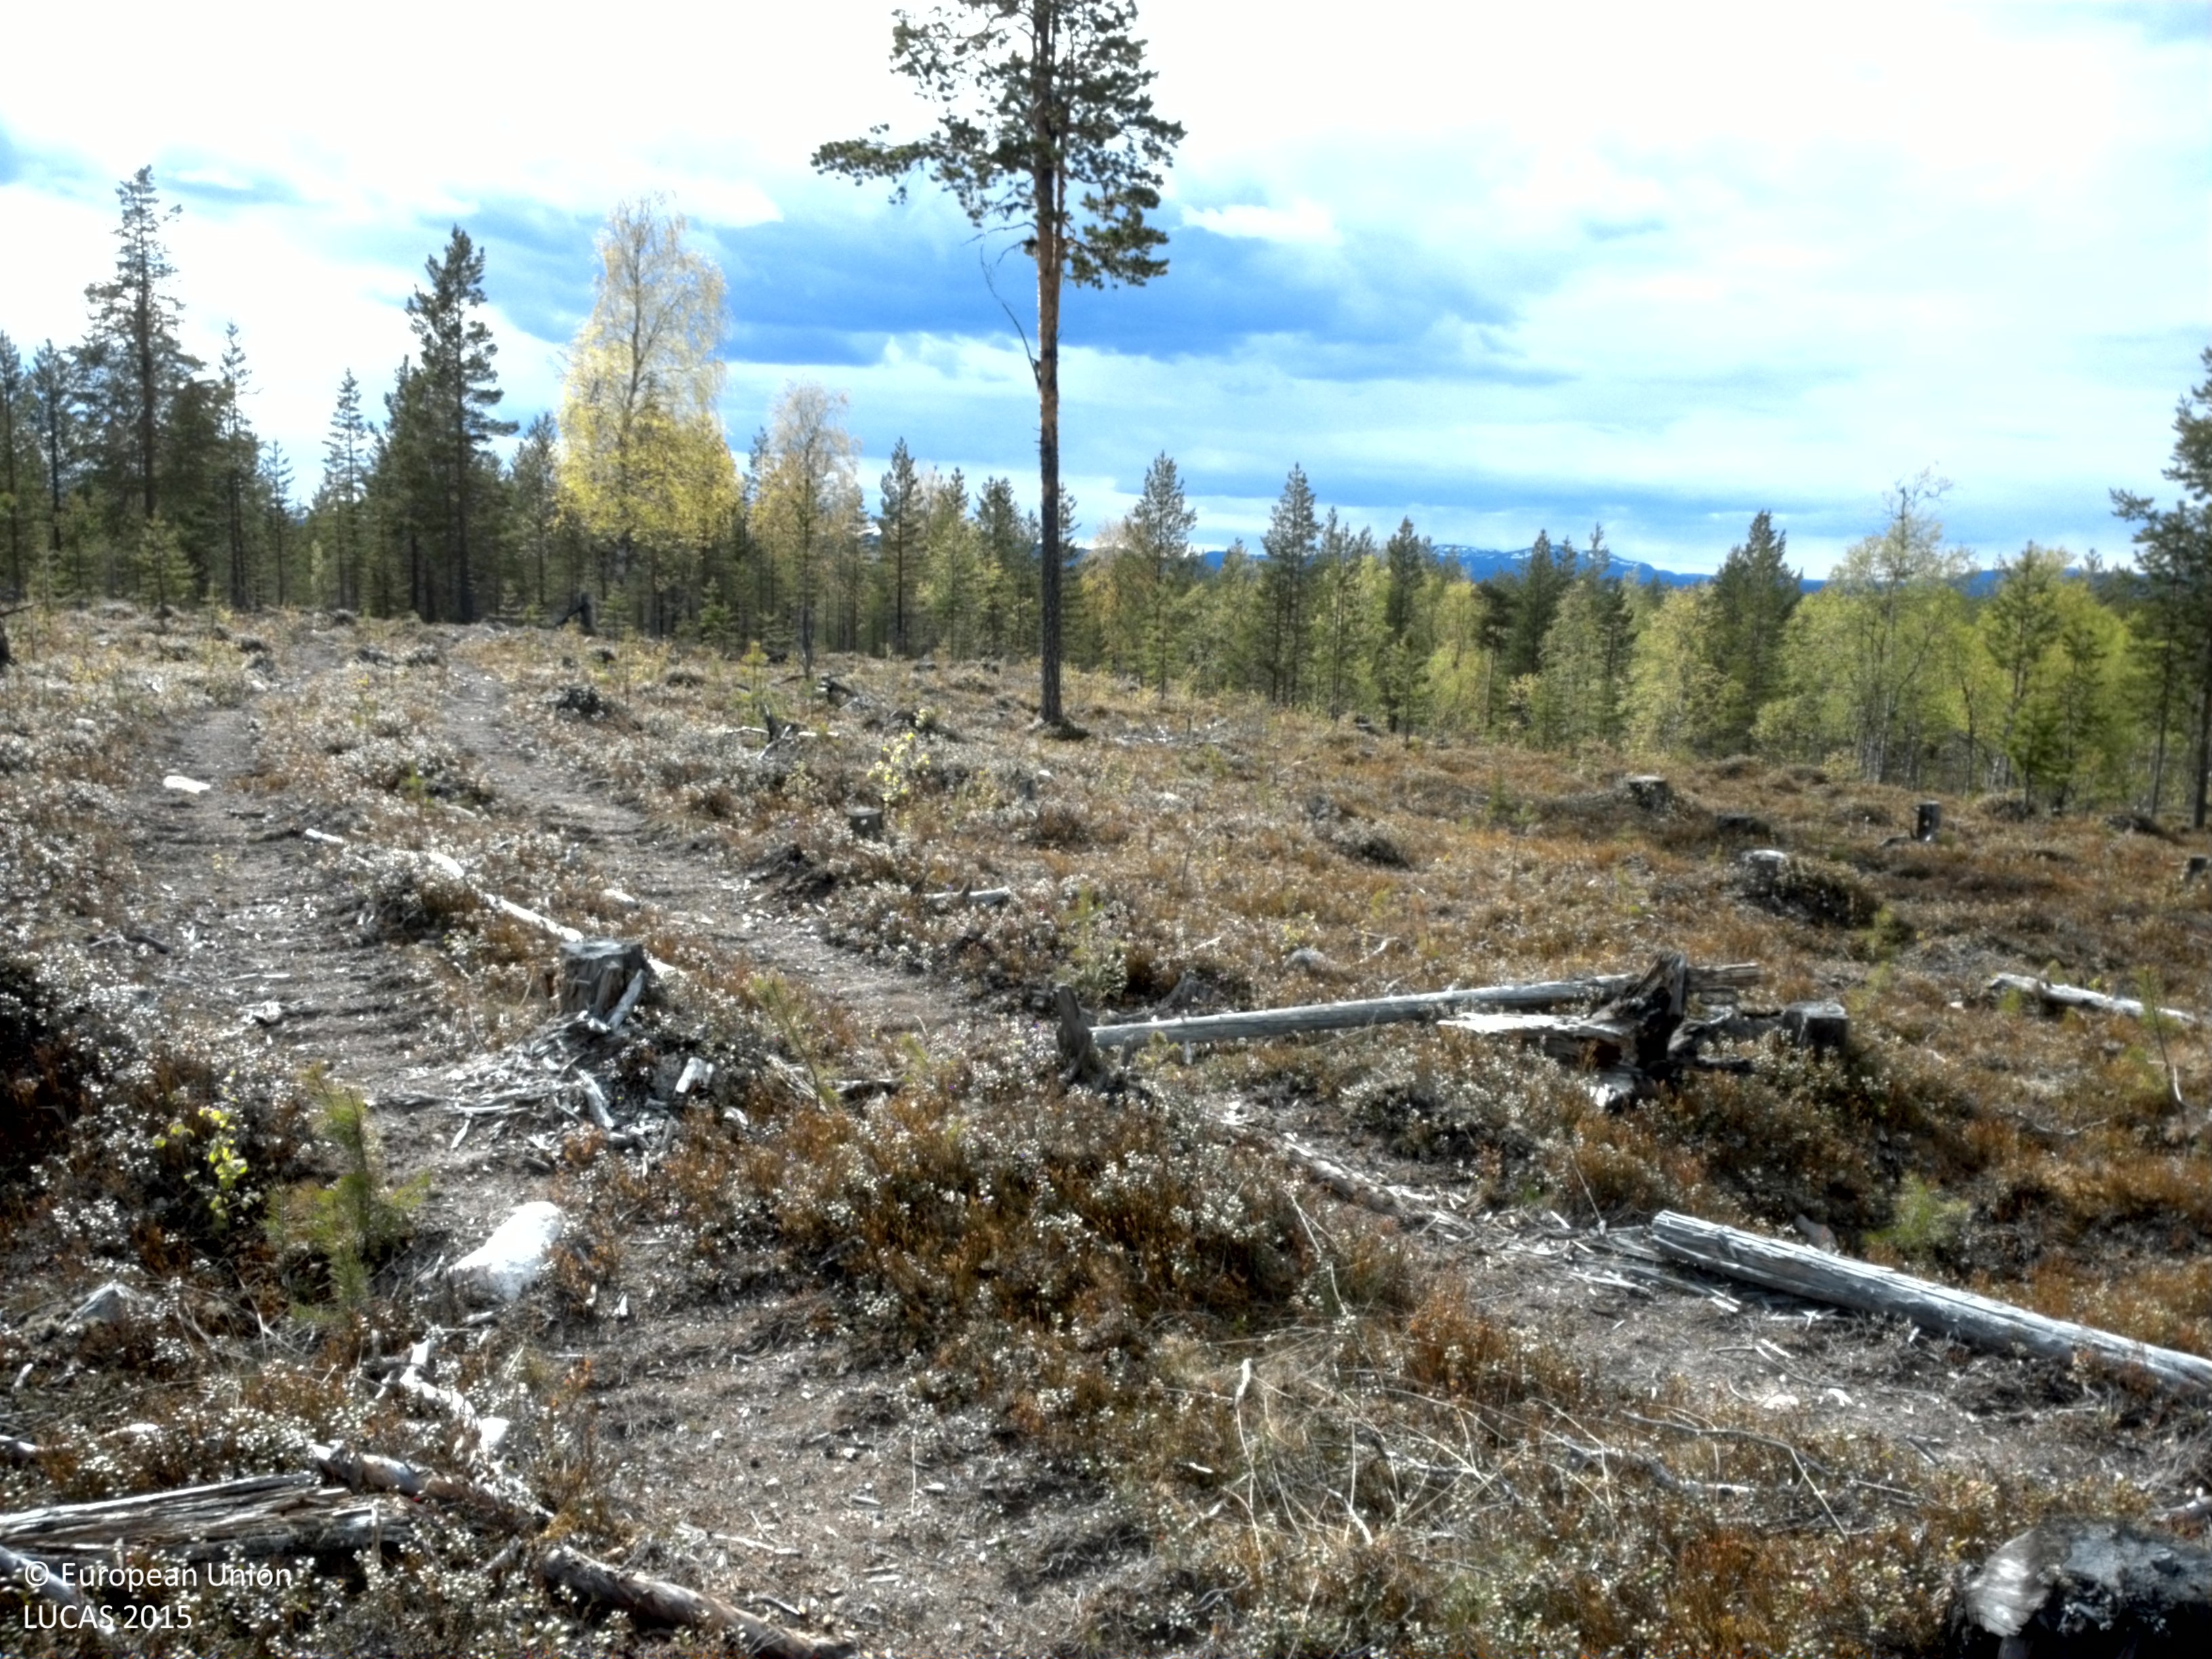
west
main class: Shrubland
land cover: Shrubland with sparse tree cover
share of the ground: > 75 %
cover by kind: shrubs 90 %, coniferous forest trees 5 %, herbaceous plants 5 %
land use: Forestry
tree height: < 5 m
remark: Clear cut
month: June
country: SE
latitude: 66.2122
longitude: 18.7745
